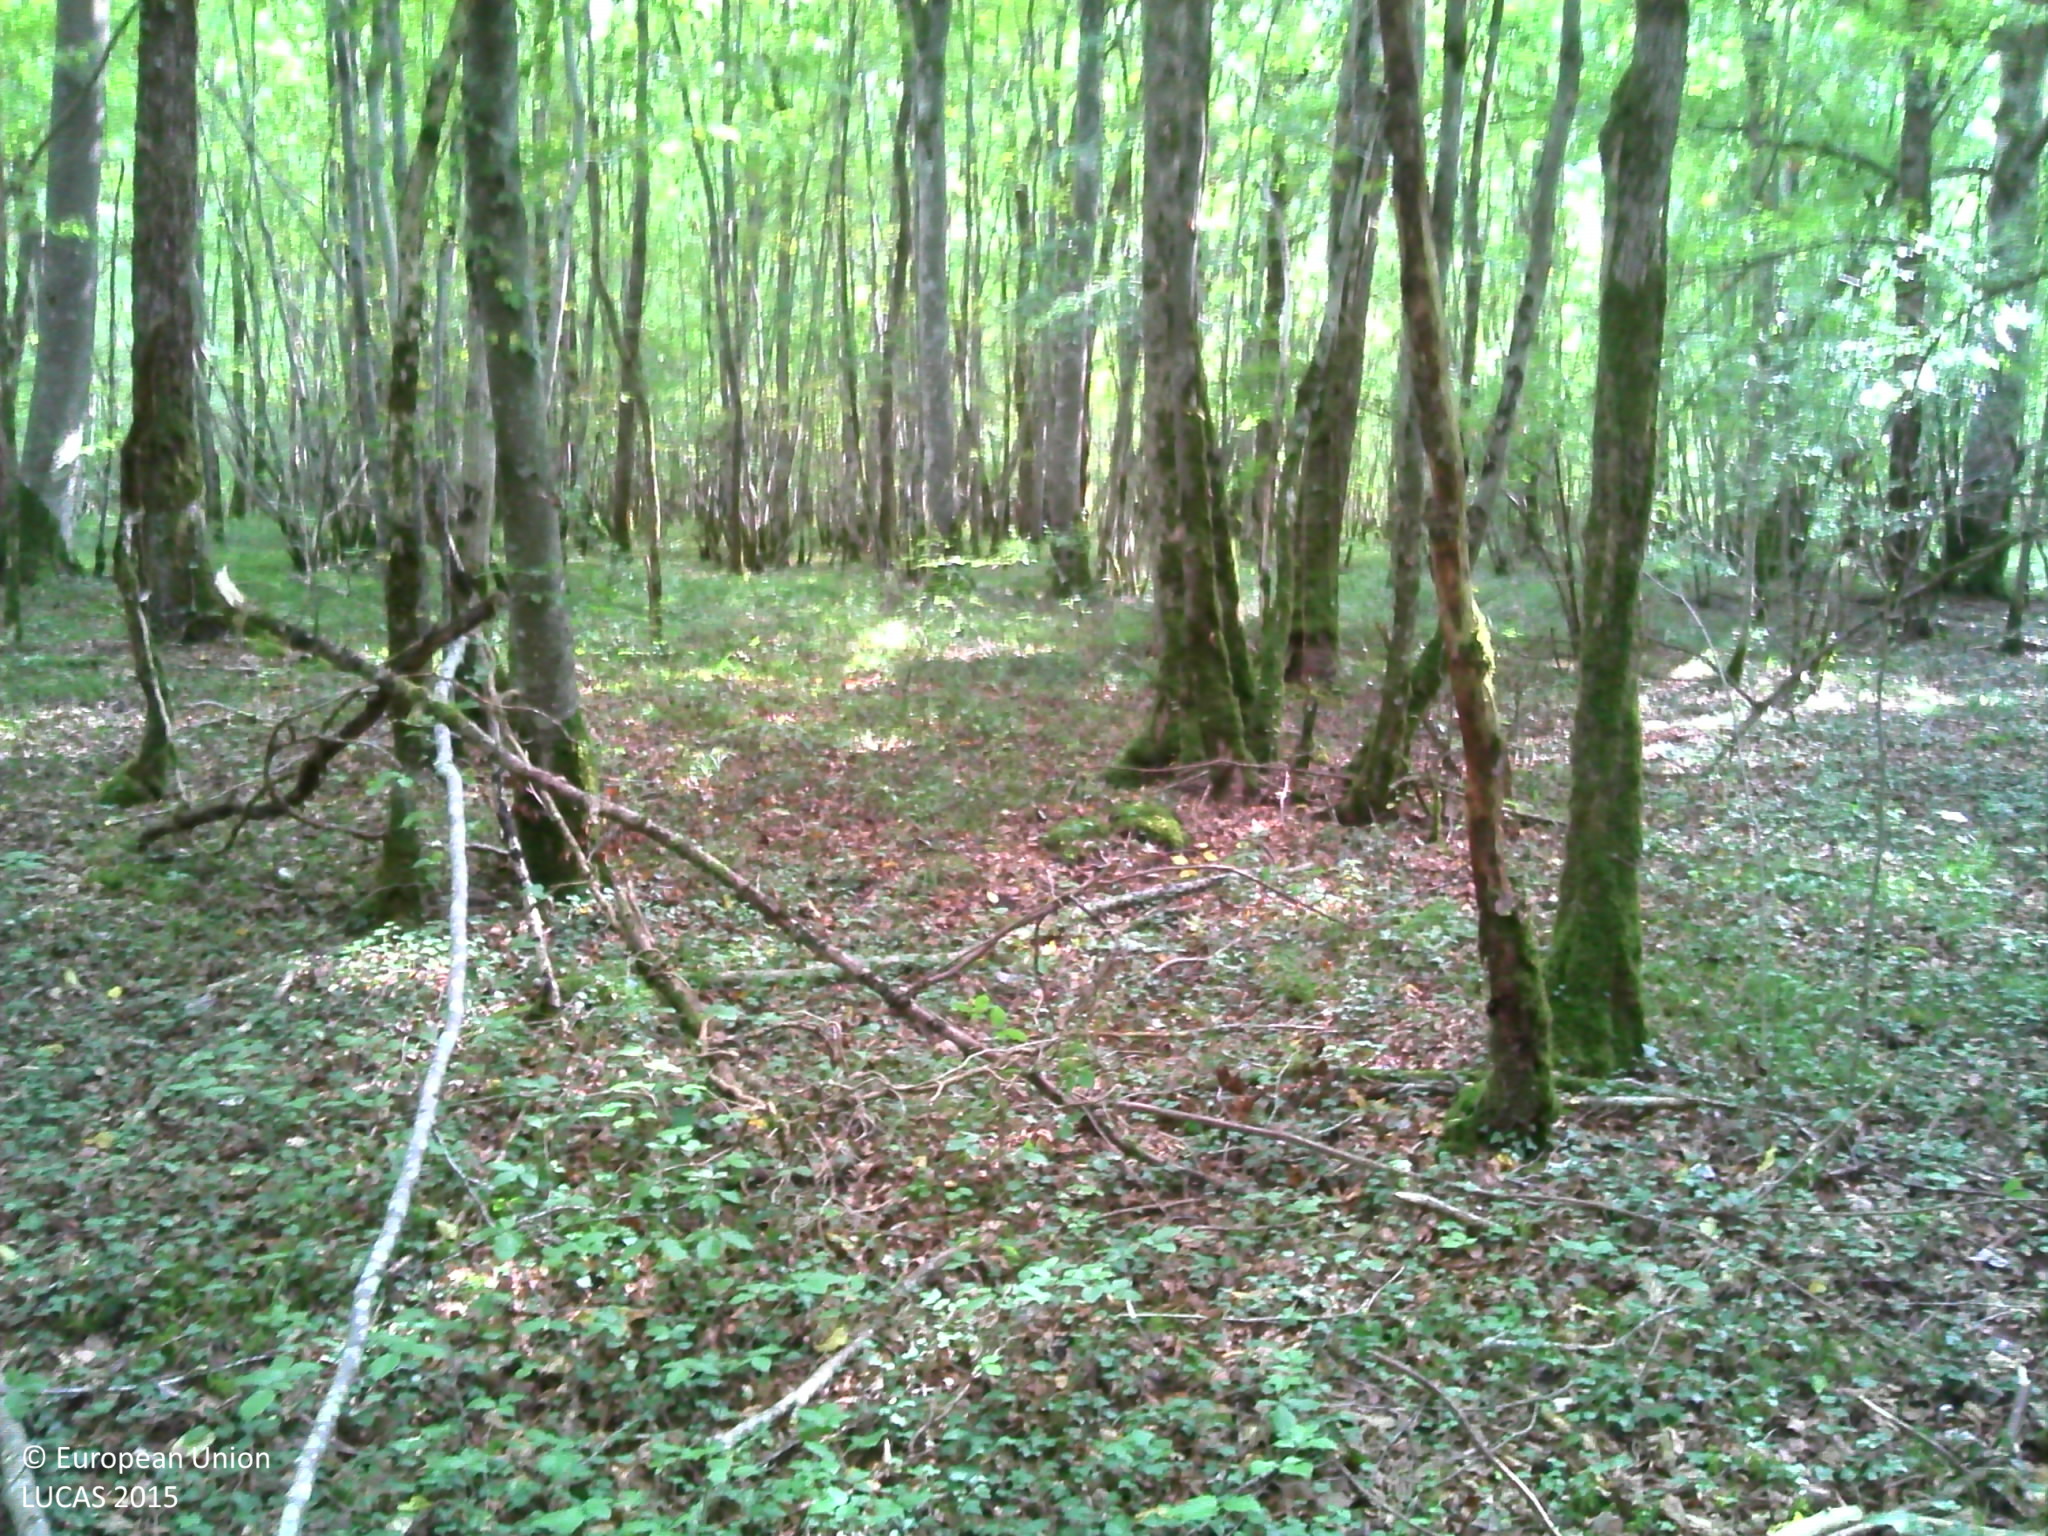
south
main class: Woodland
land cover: Broadleaved woodland
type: mesophytic deciduous forest
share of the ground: > 75 %
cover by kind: broadleaved forest trees 90 %, herbaceous plants 5 %, lichens and mosses 5 %
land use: Forestry
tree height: > 5 m
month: September
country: FR
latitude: 47.5241
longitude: 4.8067
